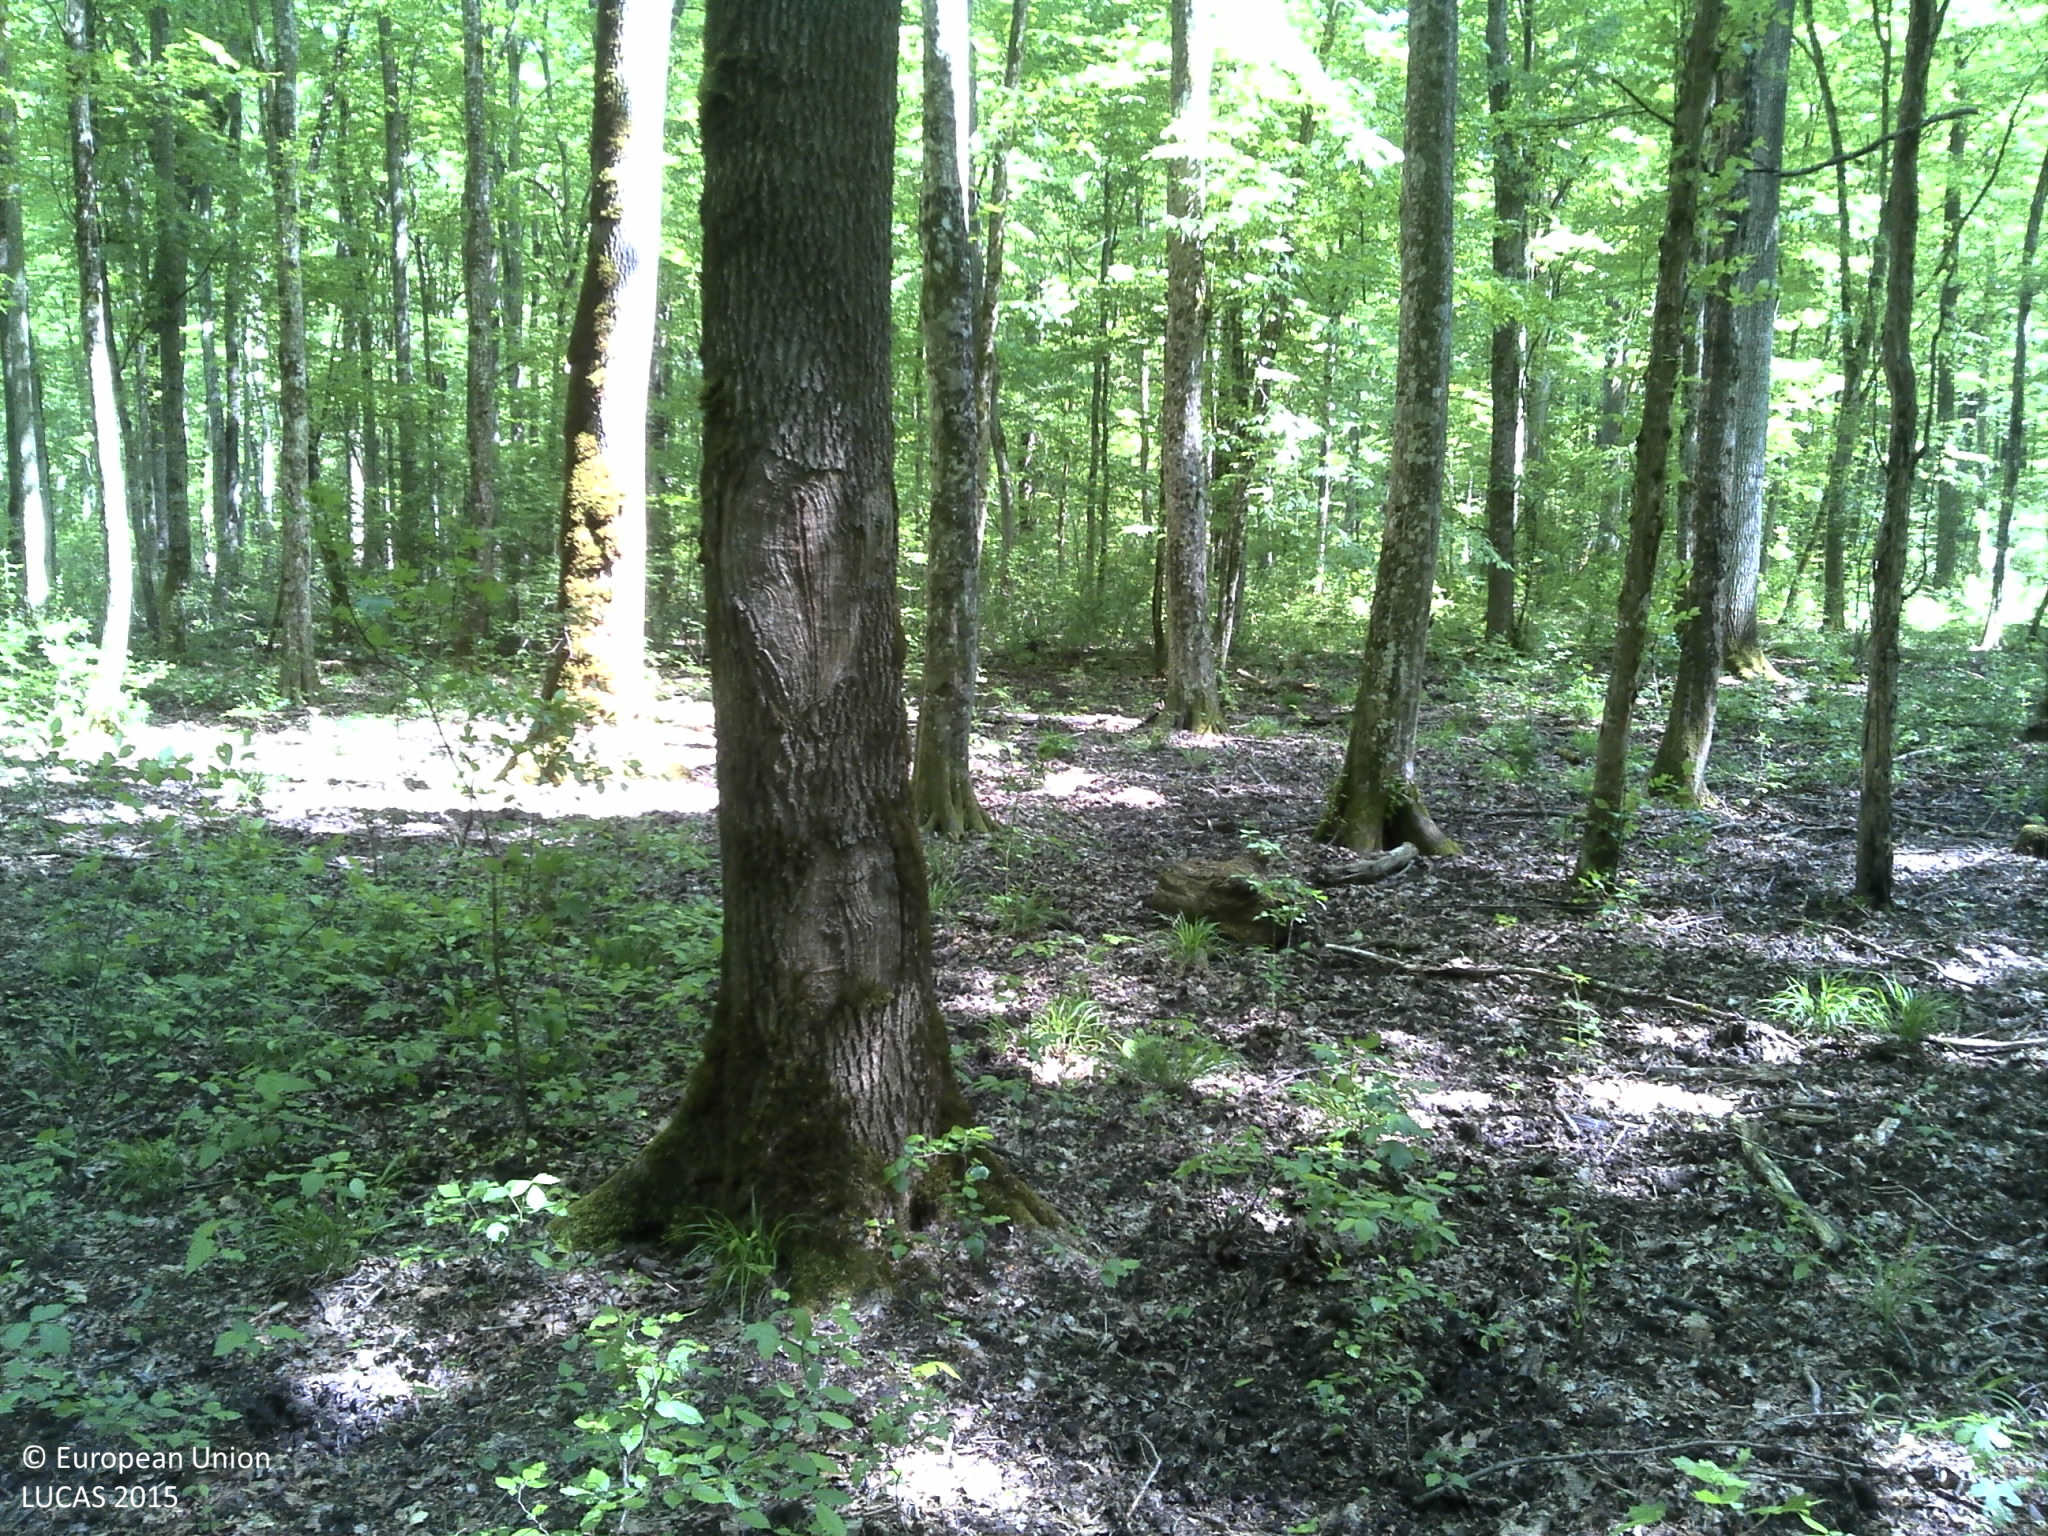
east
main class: Woodland
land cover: Broadleaved woodland
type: mesophytic deciduous forest
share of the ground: > 75 %
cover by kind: broadleaved forest trees 100 %
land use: Forestry
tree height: > 5 m
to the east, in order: Broadleaved woodland
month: April
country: HR
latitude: 45.0504
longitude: 18.9585
